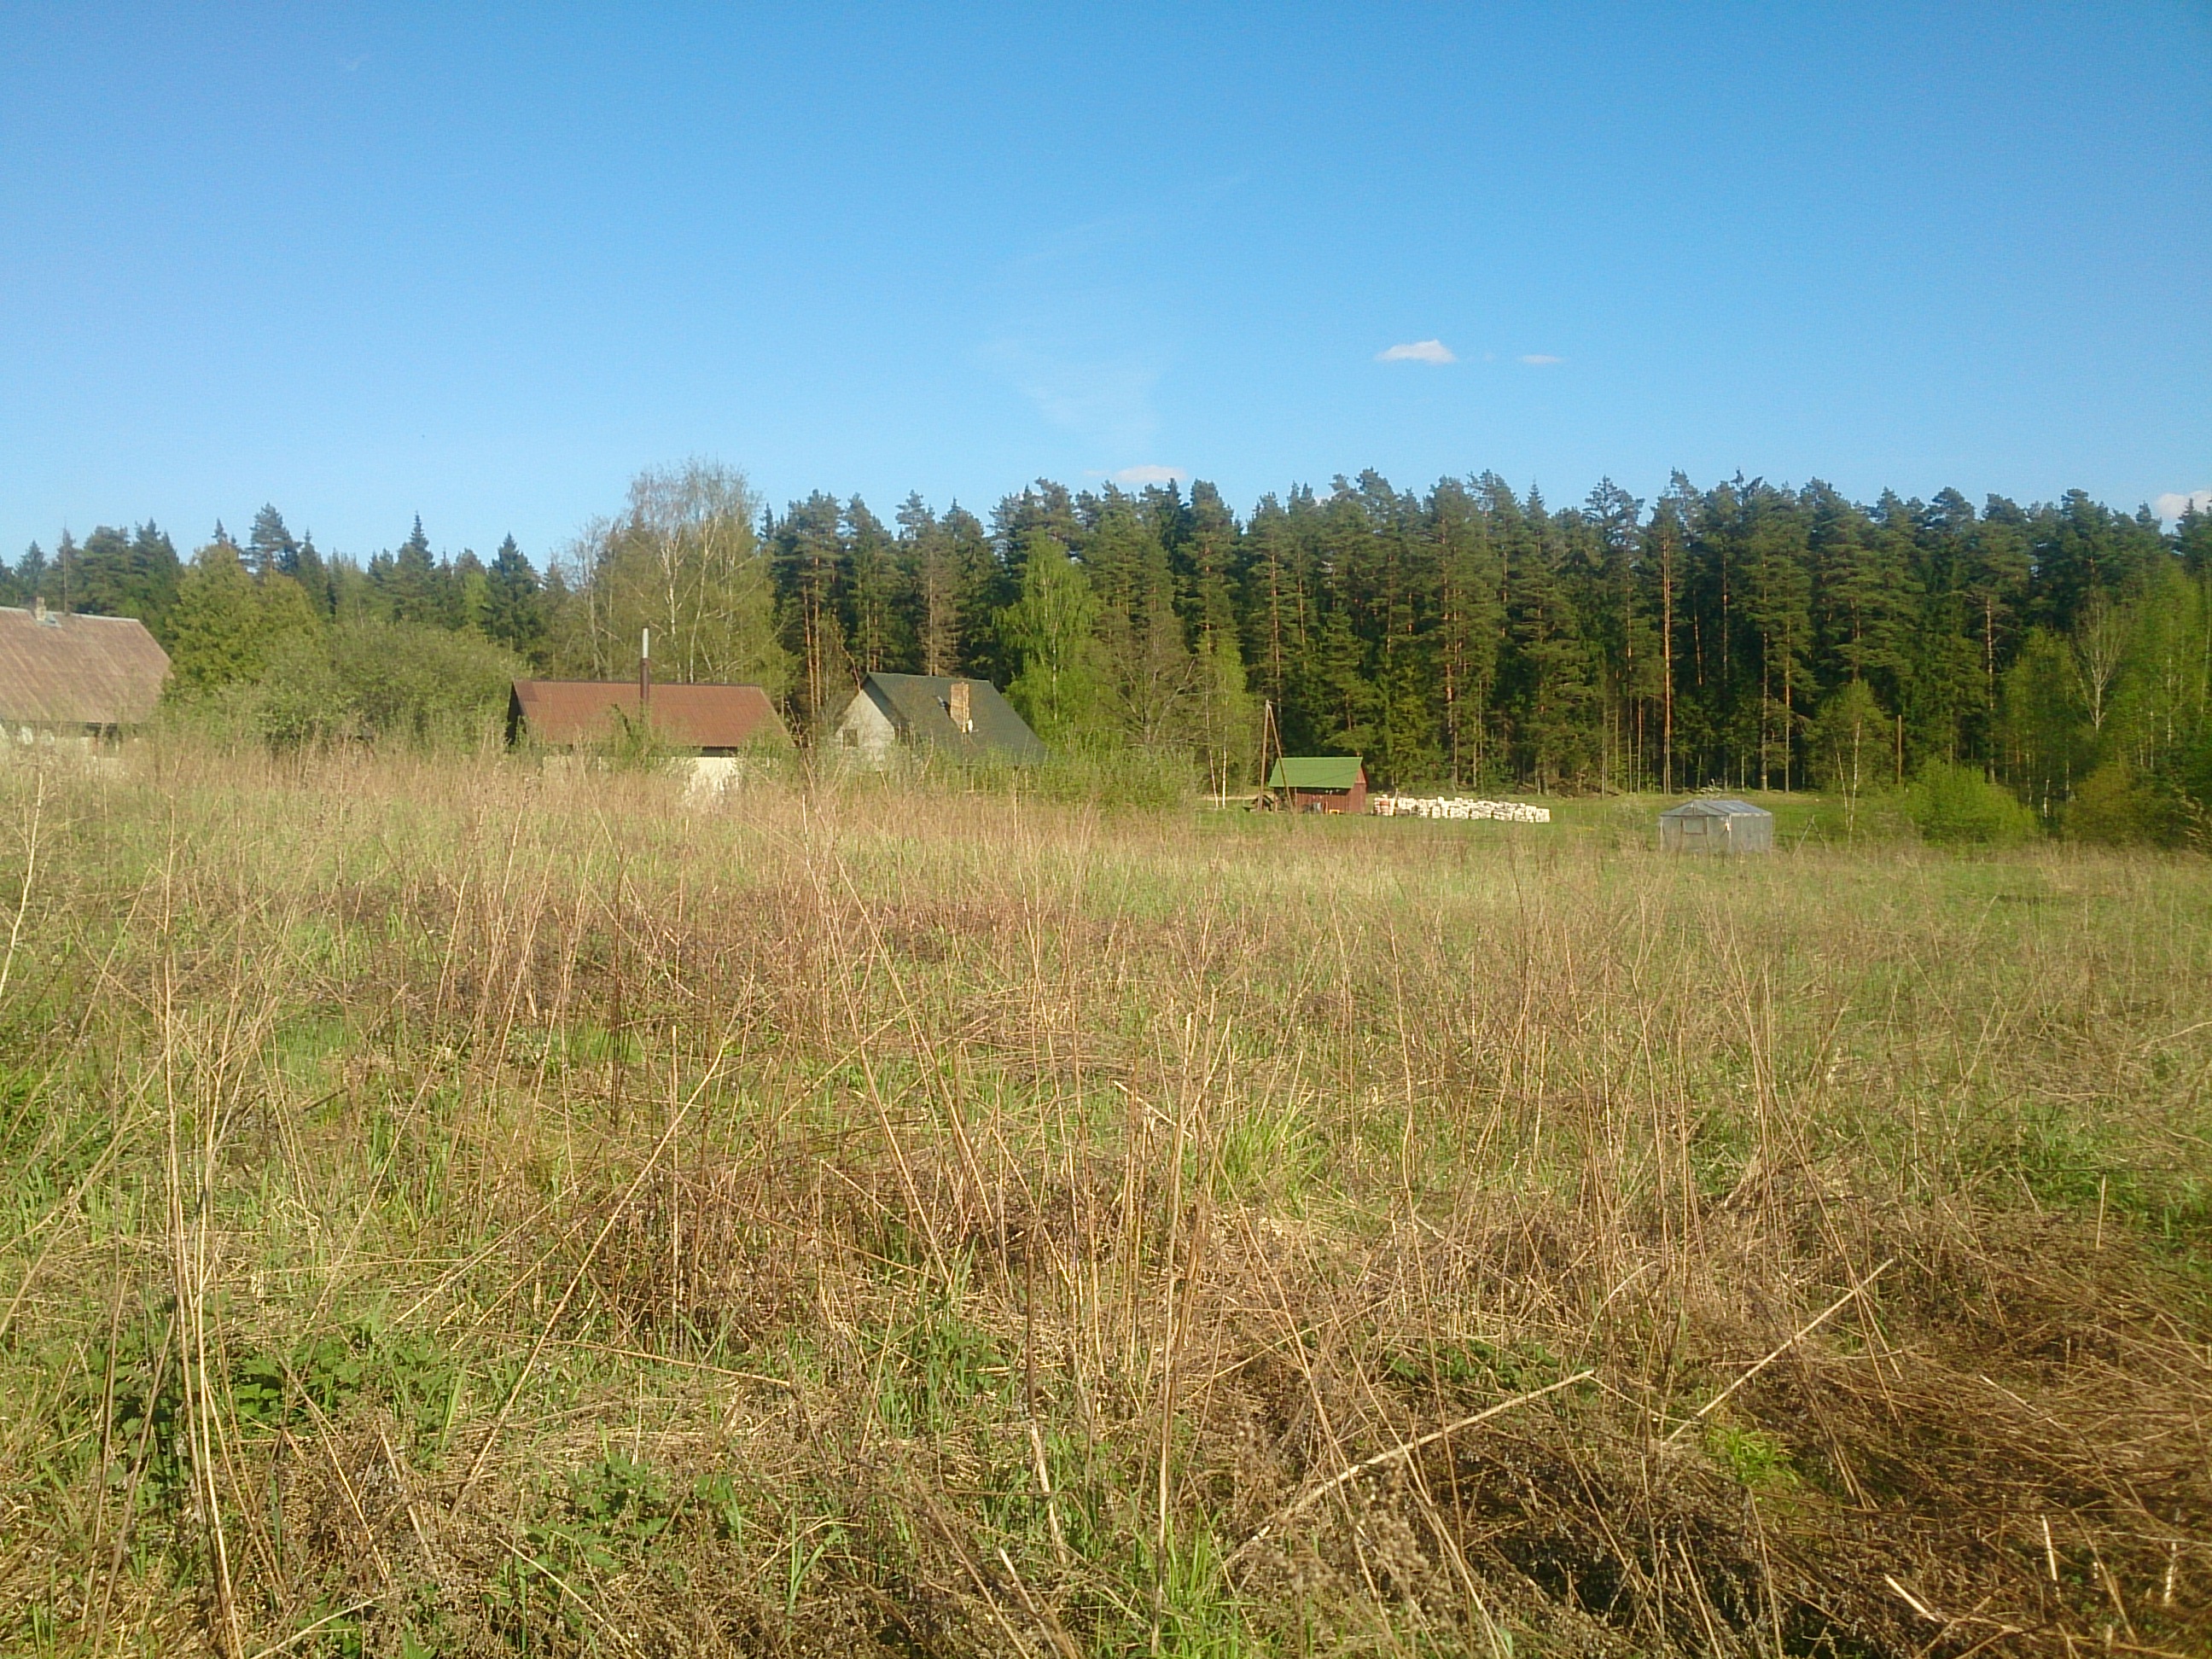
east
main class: Grassland
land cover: Spontaneously vegetated surfaces
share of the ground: > 75 %
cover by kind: herbaceous plants 100 %
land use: Agriculture (excluding fallow land and kitchen gardens)
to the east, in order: Spontaneously vegetated surfaces; Artificial constructions in urban areas; Spontaneously vegetated surfaces; Ditches and canals; Spontaneously vegetated surfaces; Other coniferous woodland; Tracks; Other coniferous woodland
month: May
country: LV
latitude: 56.7600
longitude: 24.4054
